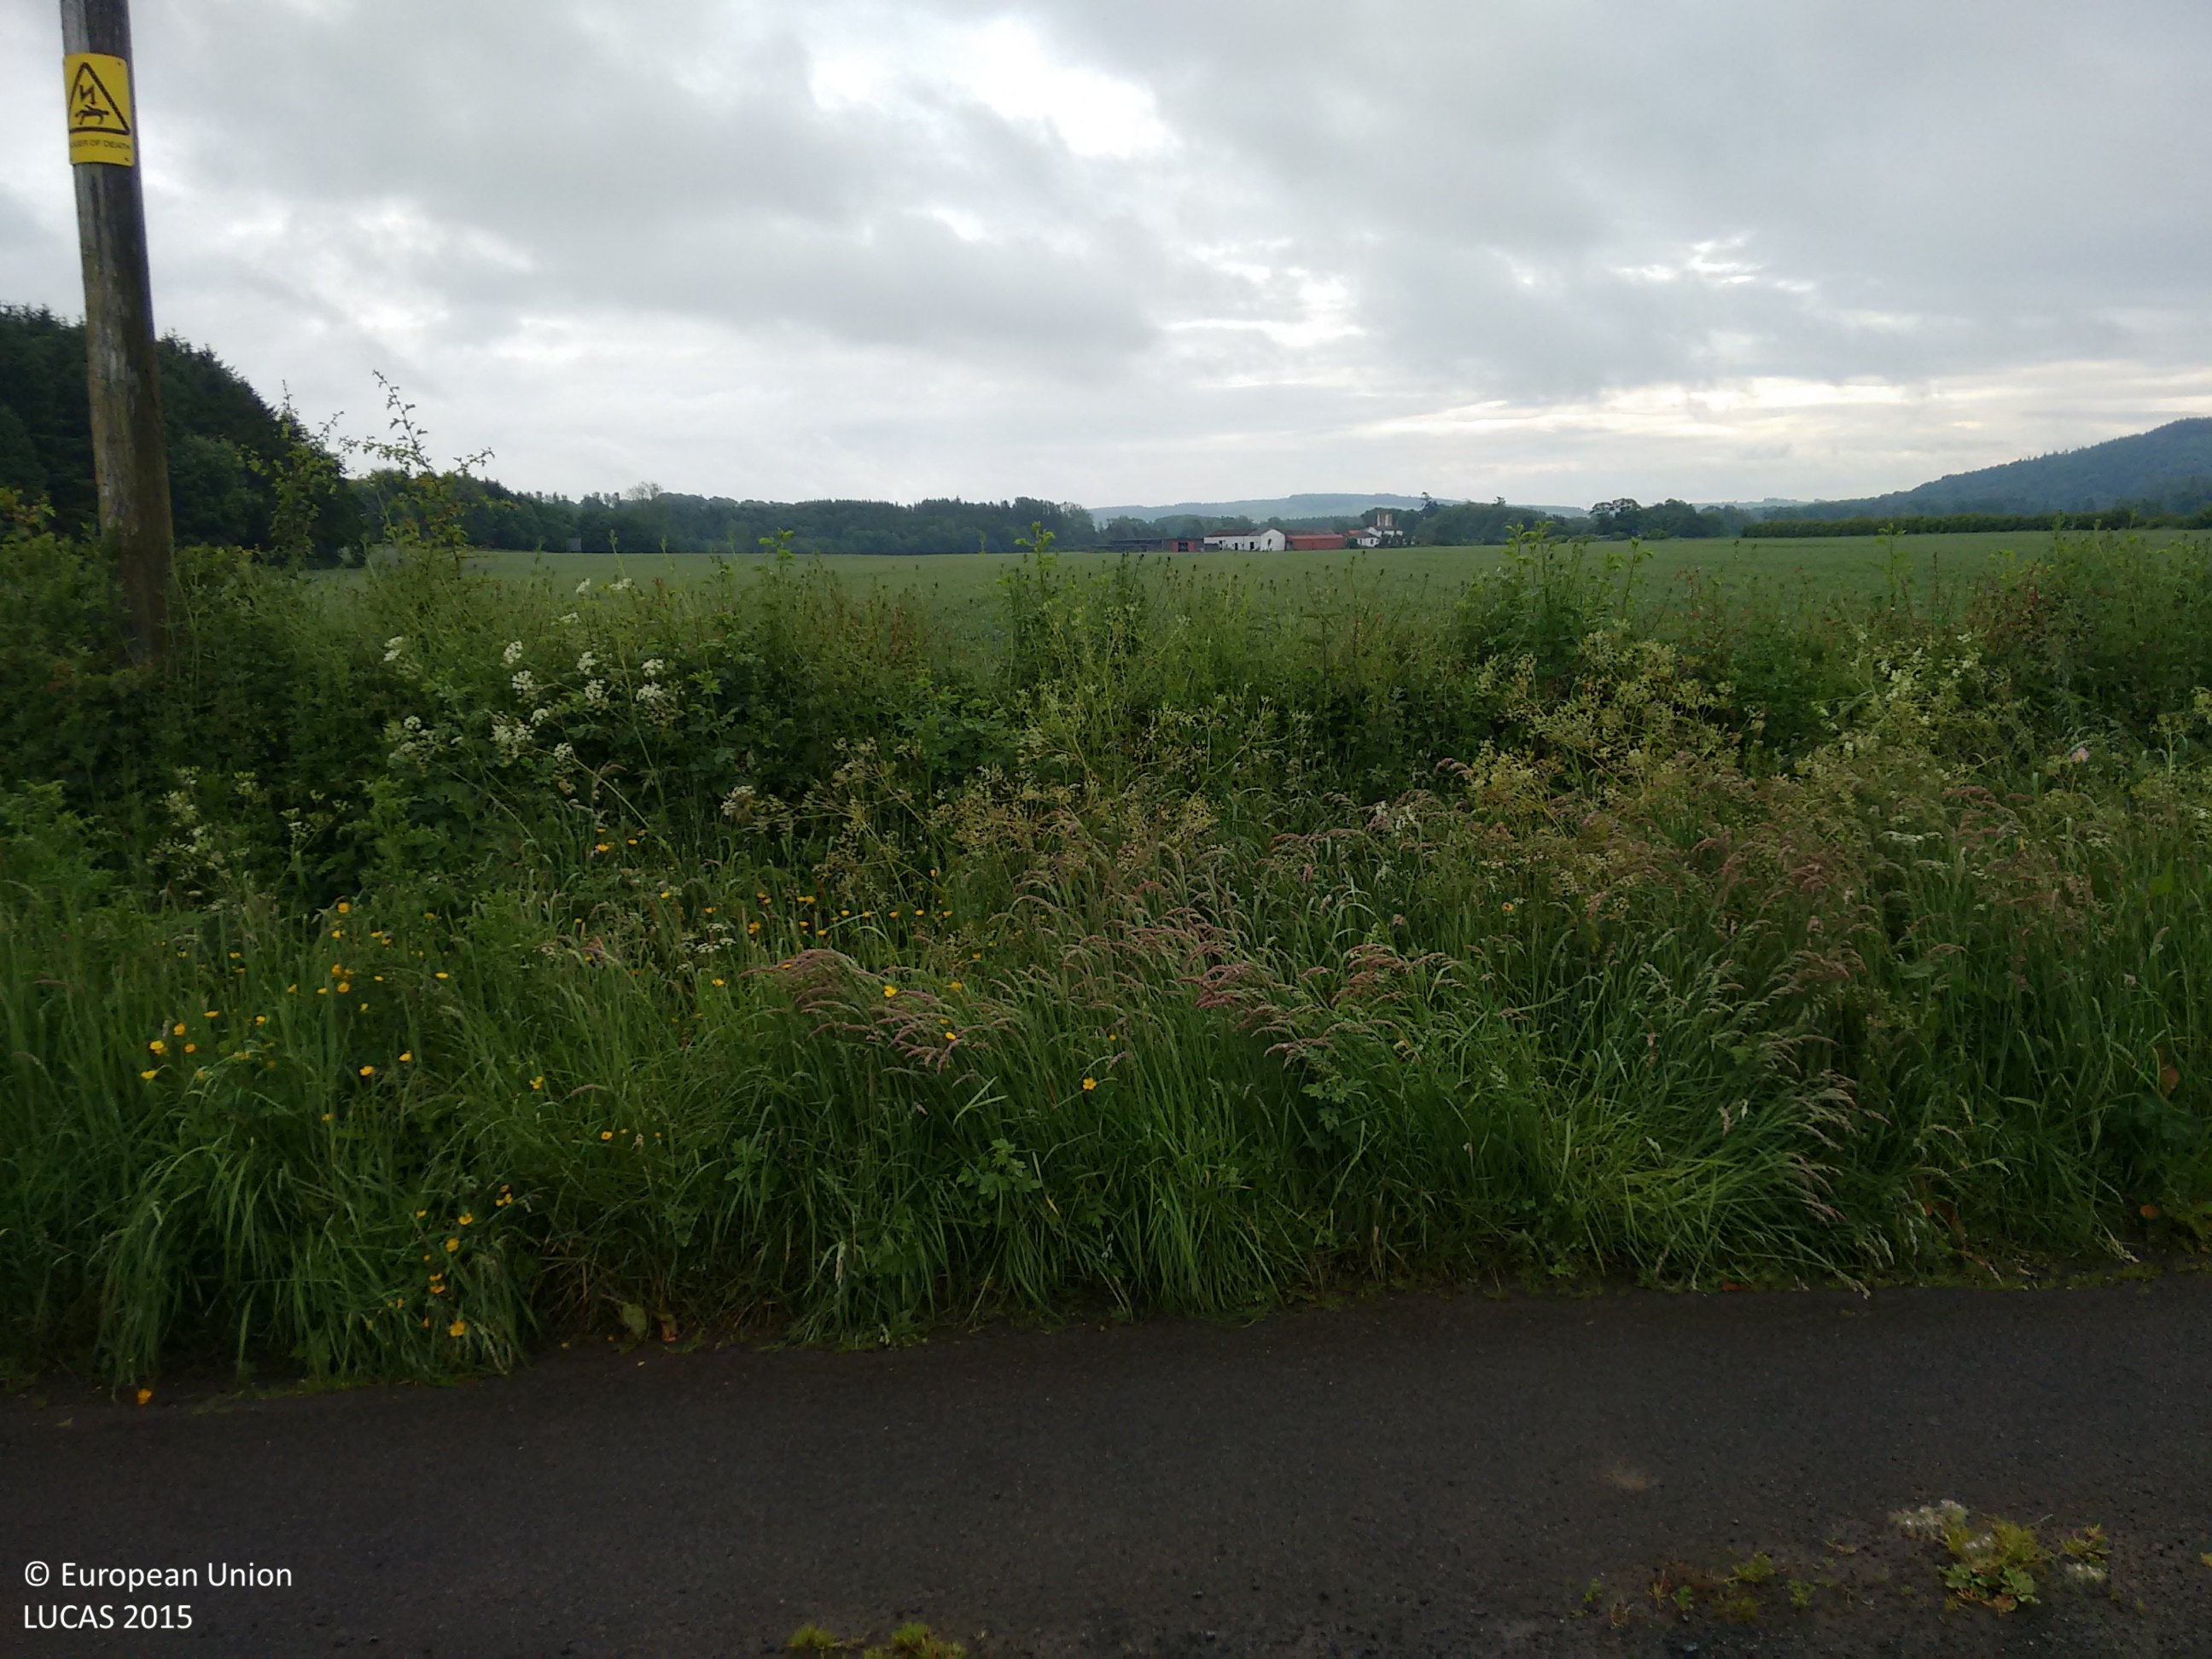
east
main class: Grassland
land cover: Grassland without tree/shrub cover
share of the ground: > 75 %
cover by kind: herbaceous plants 100 %
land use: Agriculture (excluding fallow land and kitchen gardens)
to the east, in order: Grassland without tree/shrub cover; Ditches and canals; Single bushes/trees; Grassland without tree/shrub cover; Fences; Grass margins; Fences; Managed hedges; Grass margins; Paved roads, cycling and walking lanes; Grass margins; Abandoned hedges; Electric lines; Fences; Grass margins; Common wheat
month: June
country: GB
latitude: 55.0496
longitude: -3.3348
